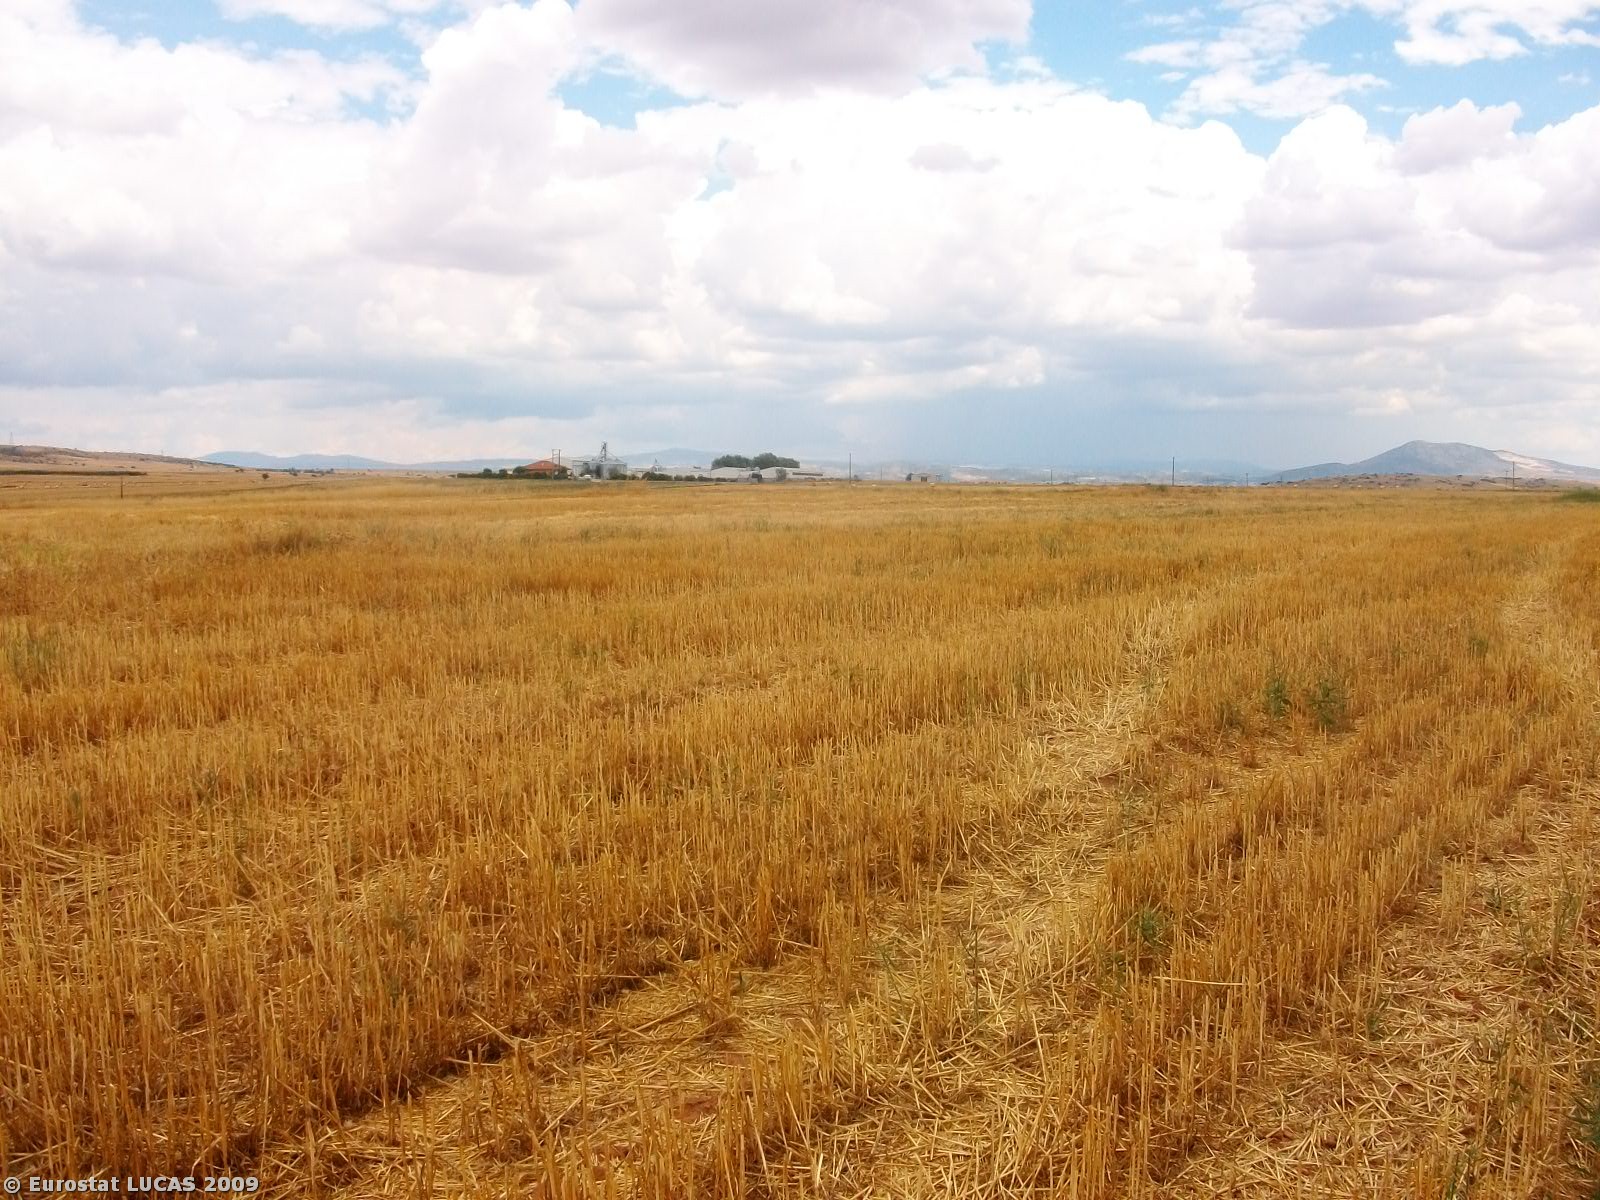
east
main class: Cropland
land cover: Durum wheat
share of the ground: > 75 %
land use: Agriculture (excluding fallow land and kitchen gardens)
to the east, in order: Durum wheat; Grass margins; Rye; Grass margins; Durum wheat
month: June
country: GR
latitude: 40.8537
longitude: 22.7835
